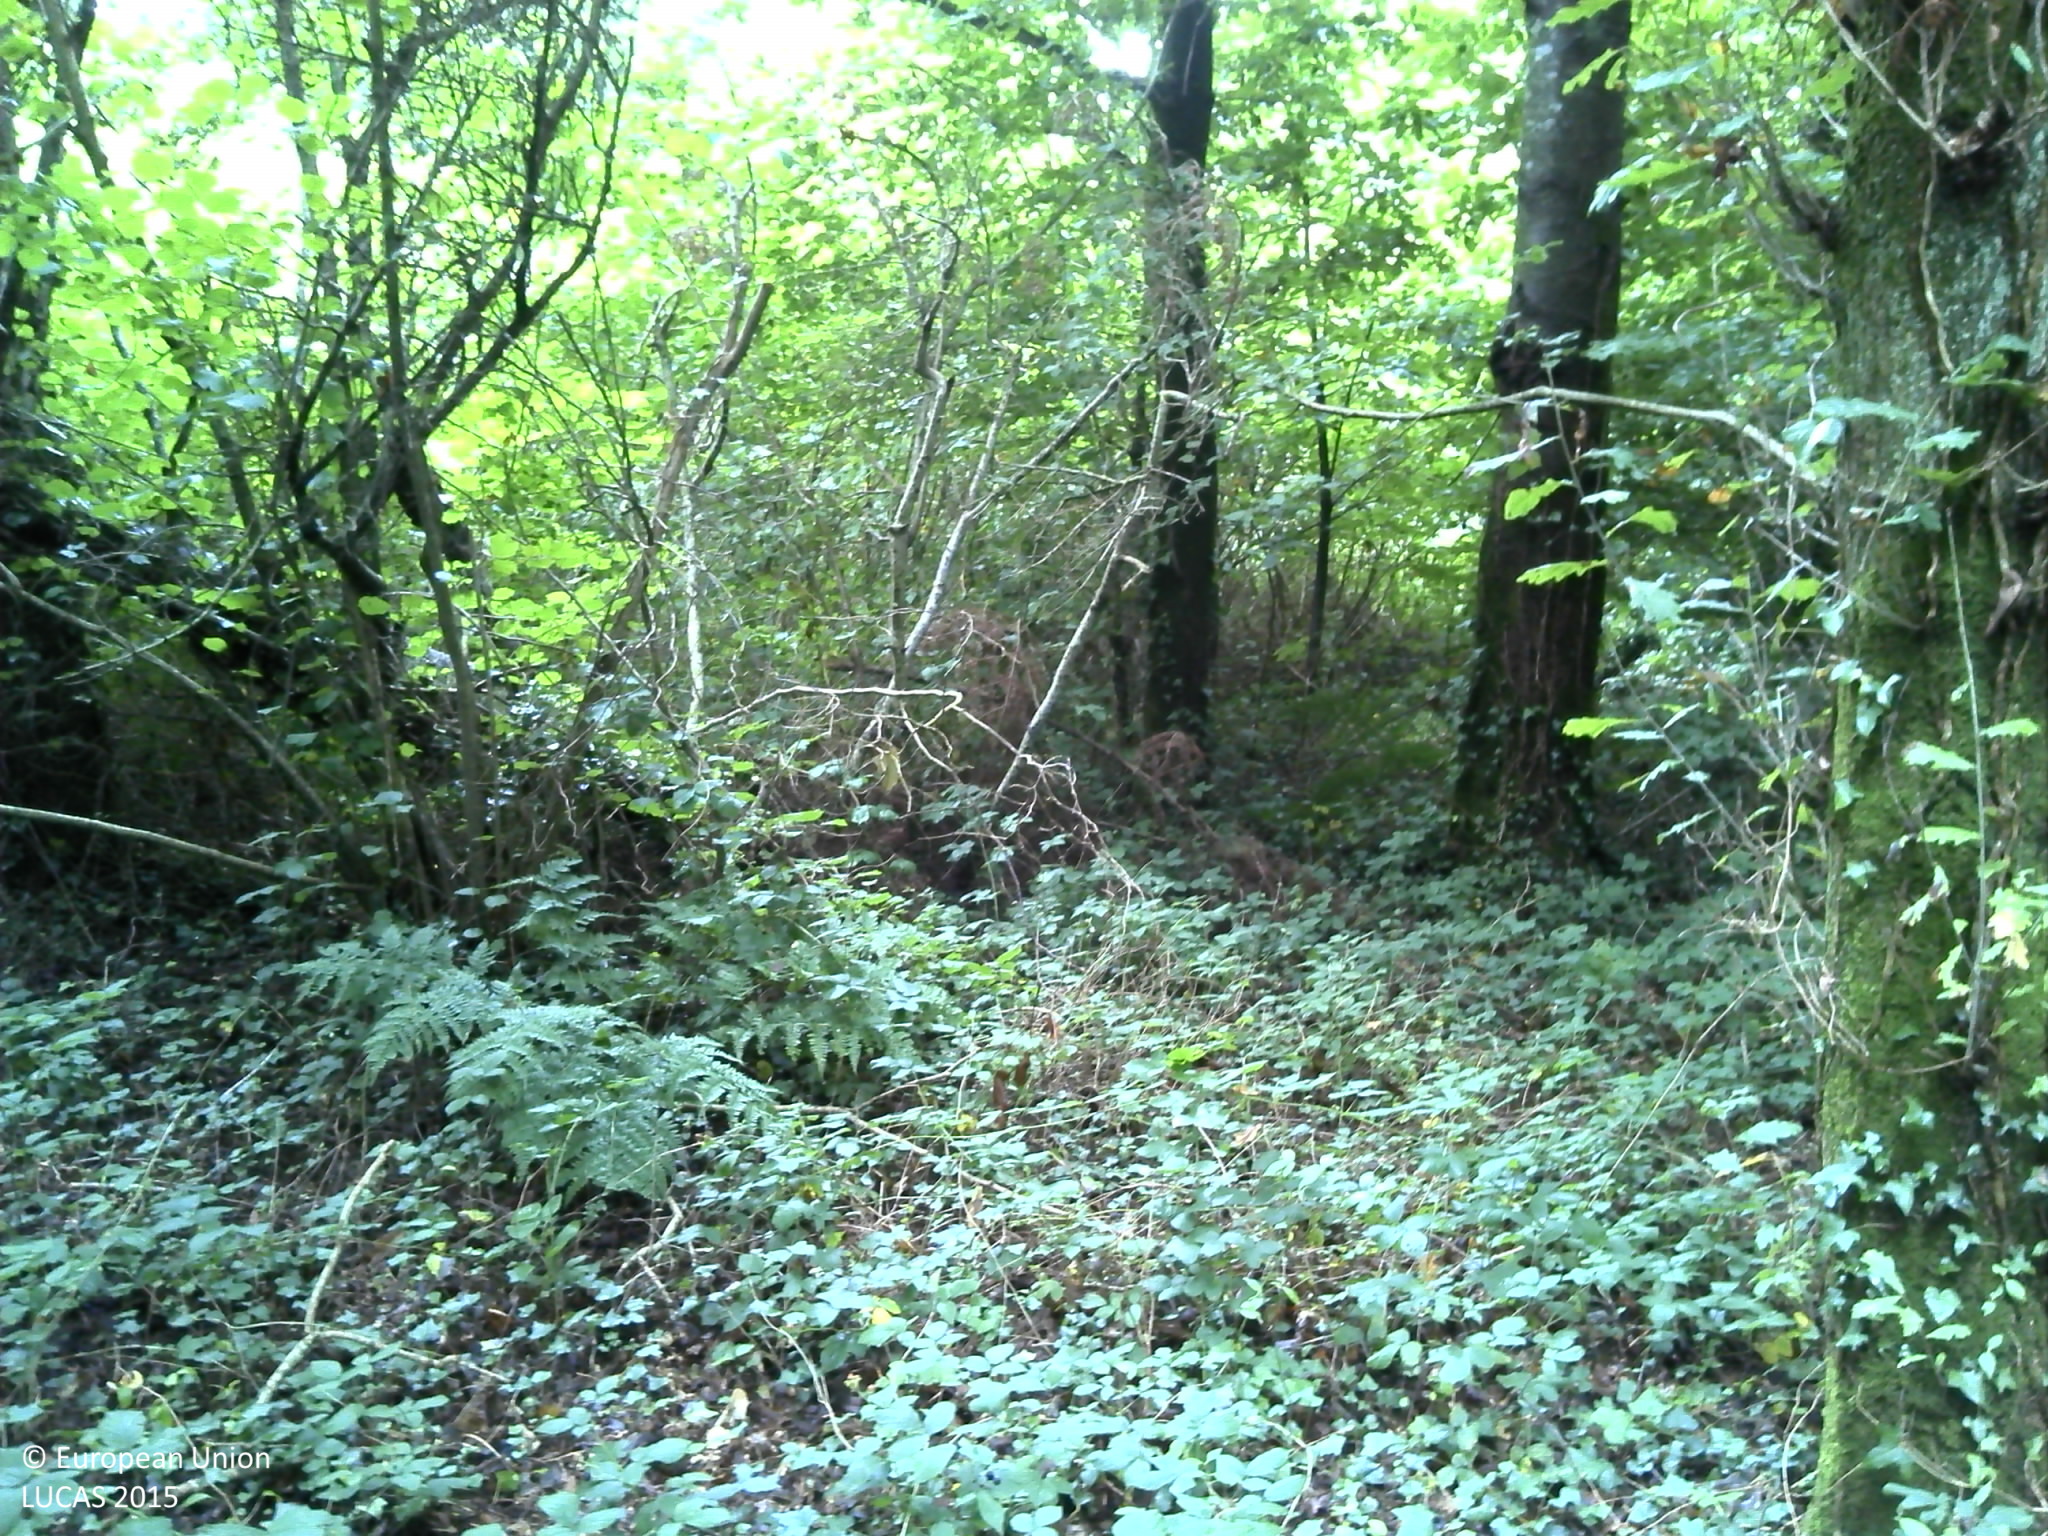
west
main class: Woodland
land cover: Broadleaved woodland
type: beech forest
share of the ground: > 75 %
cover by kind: broadleaved forest trees 100 %
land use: Forestry
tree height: > 5 m
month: August
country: FR
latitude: 48.4821
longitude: -4.5075
